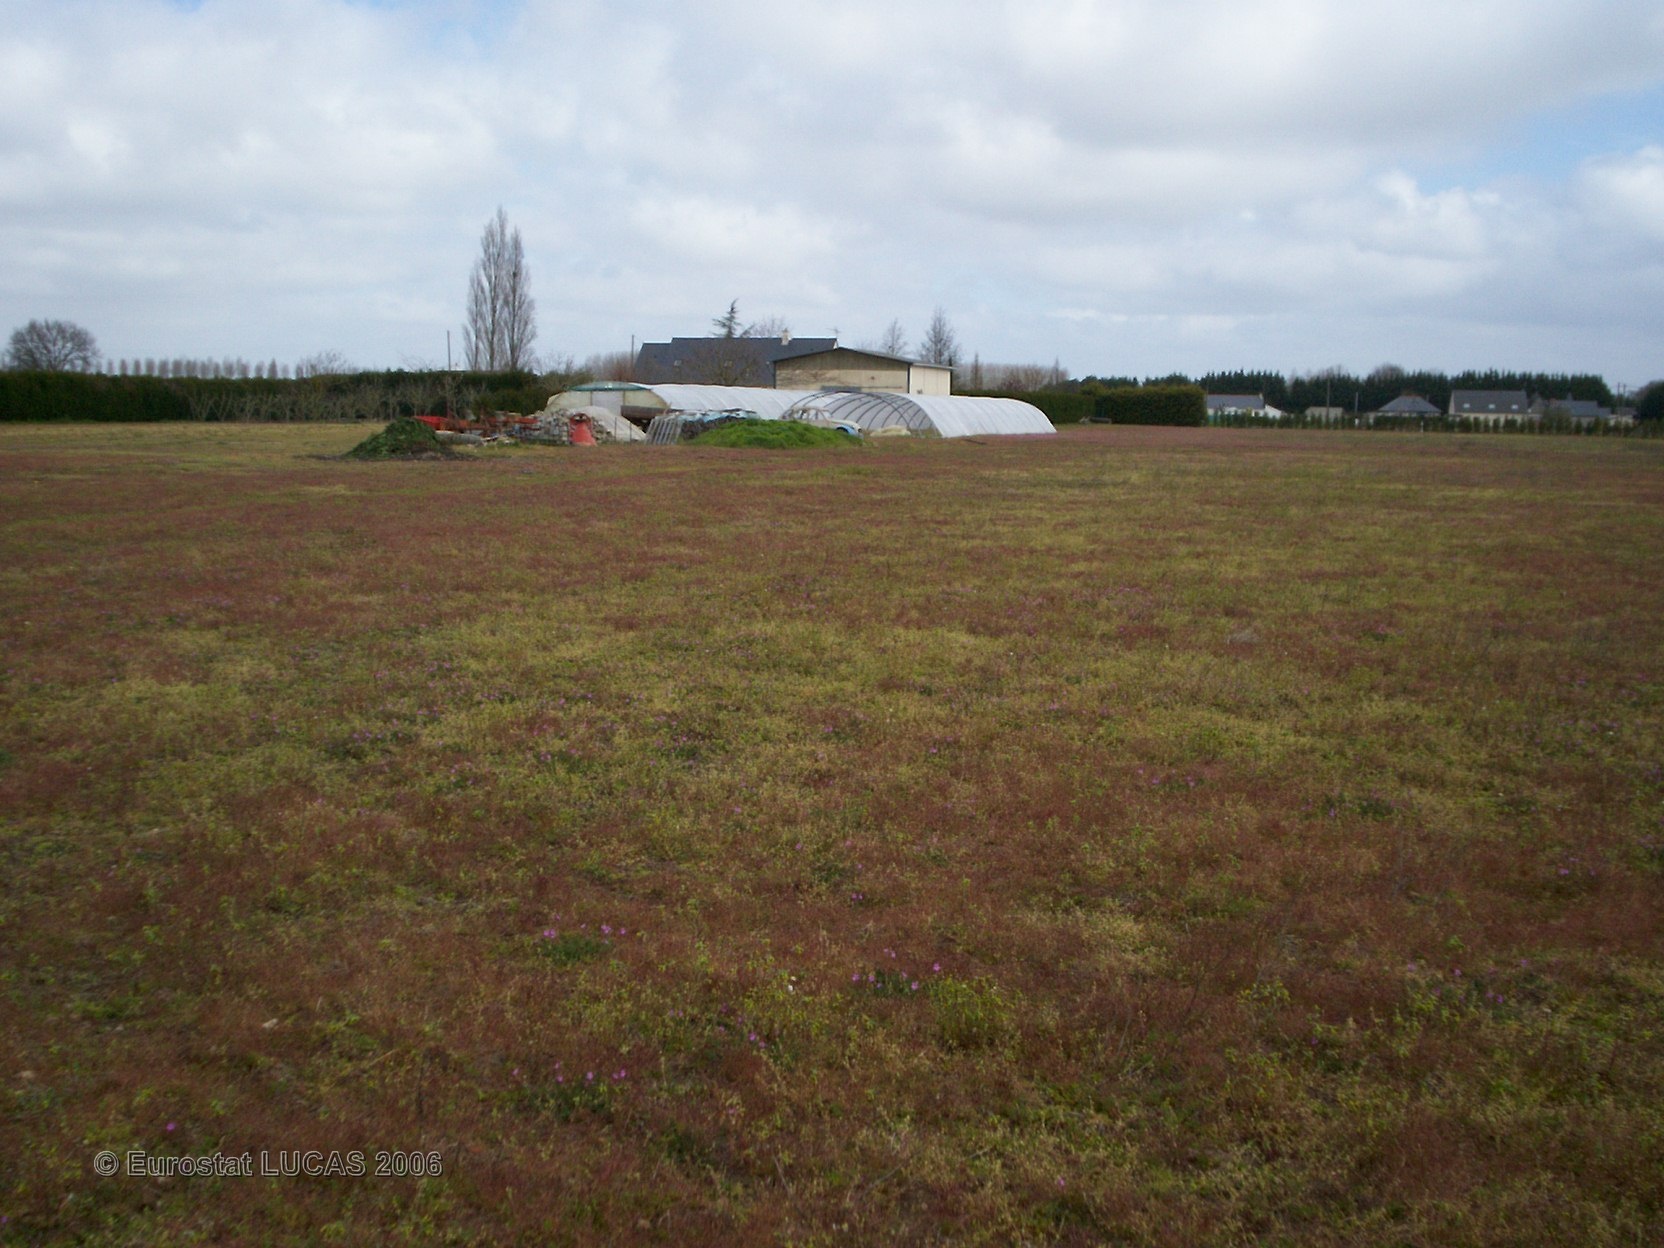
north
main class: Grassland
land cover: Grassland without tree/shrub cover
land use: Agriculture (excluding fallow land and kitchen gardens)
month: April
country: FR
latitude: 47.4566
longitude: -0.4159
